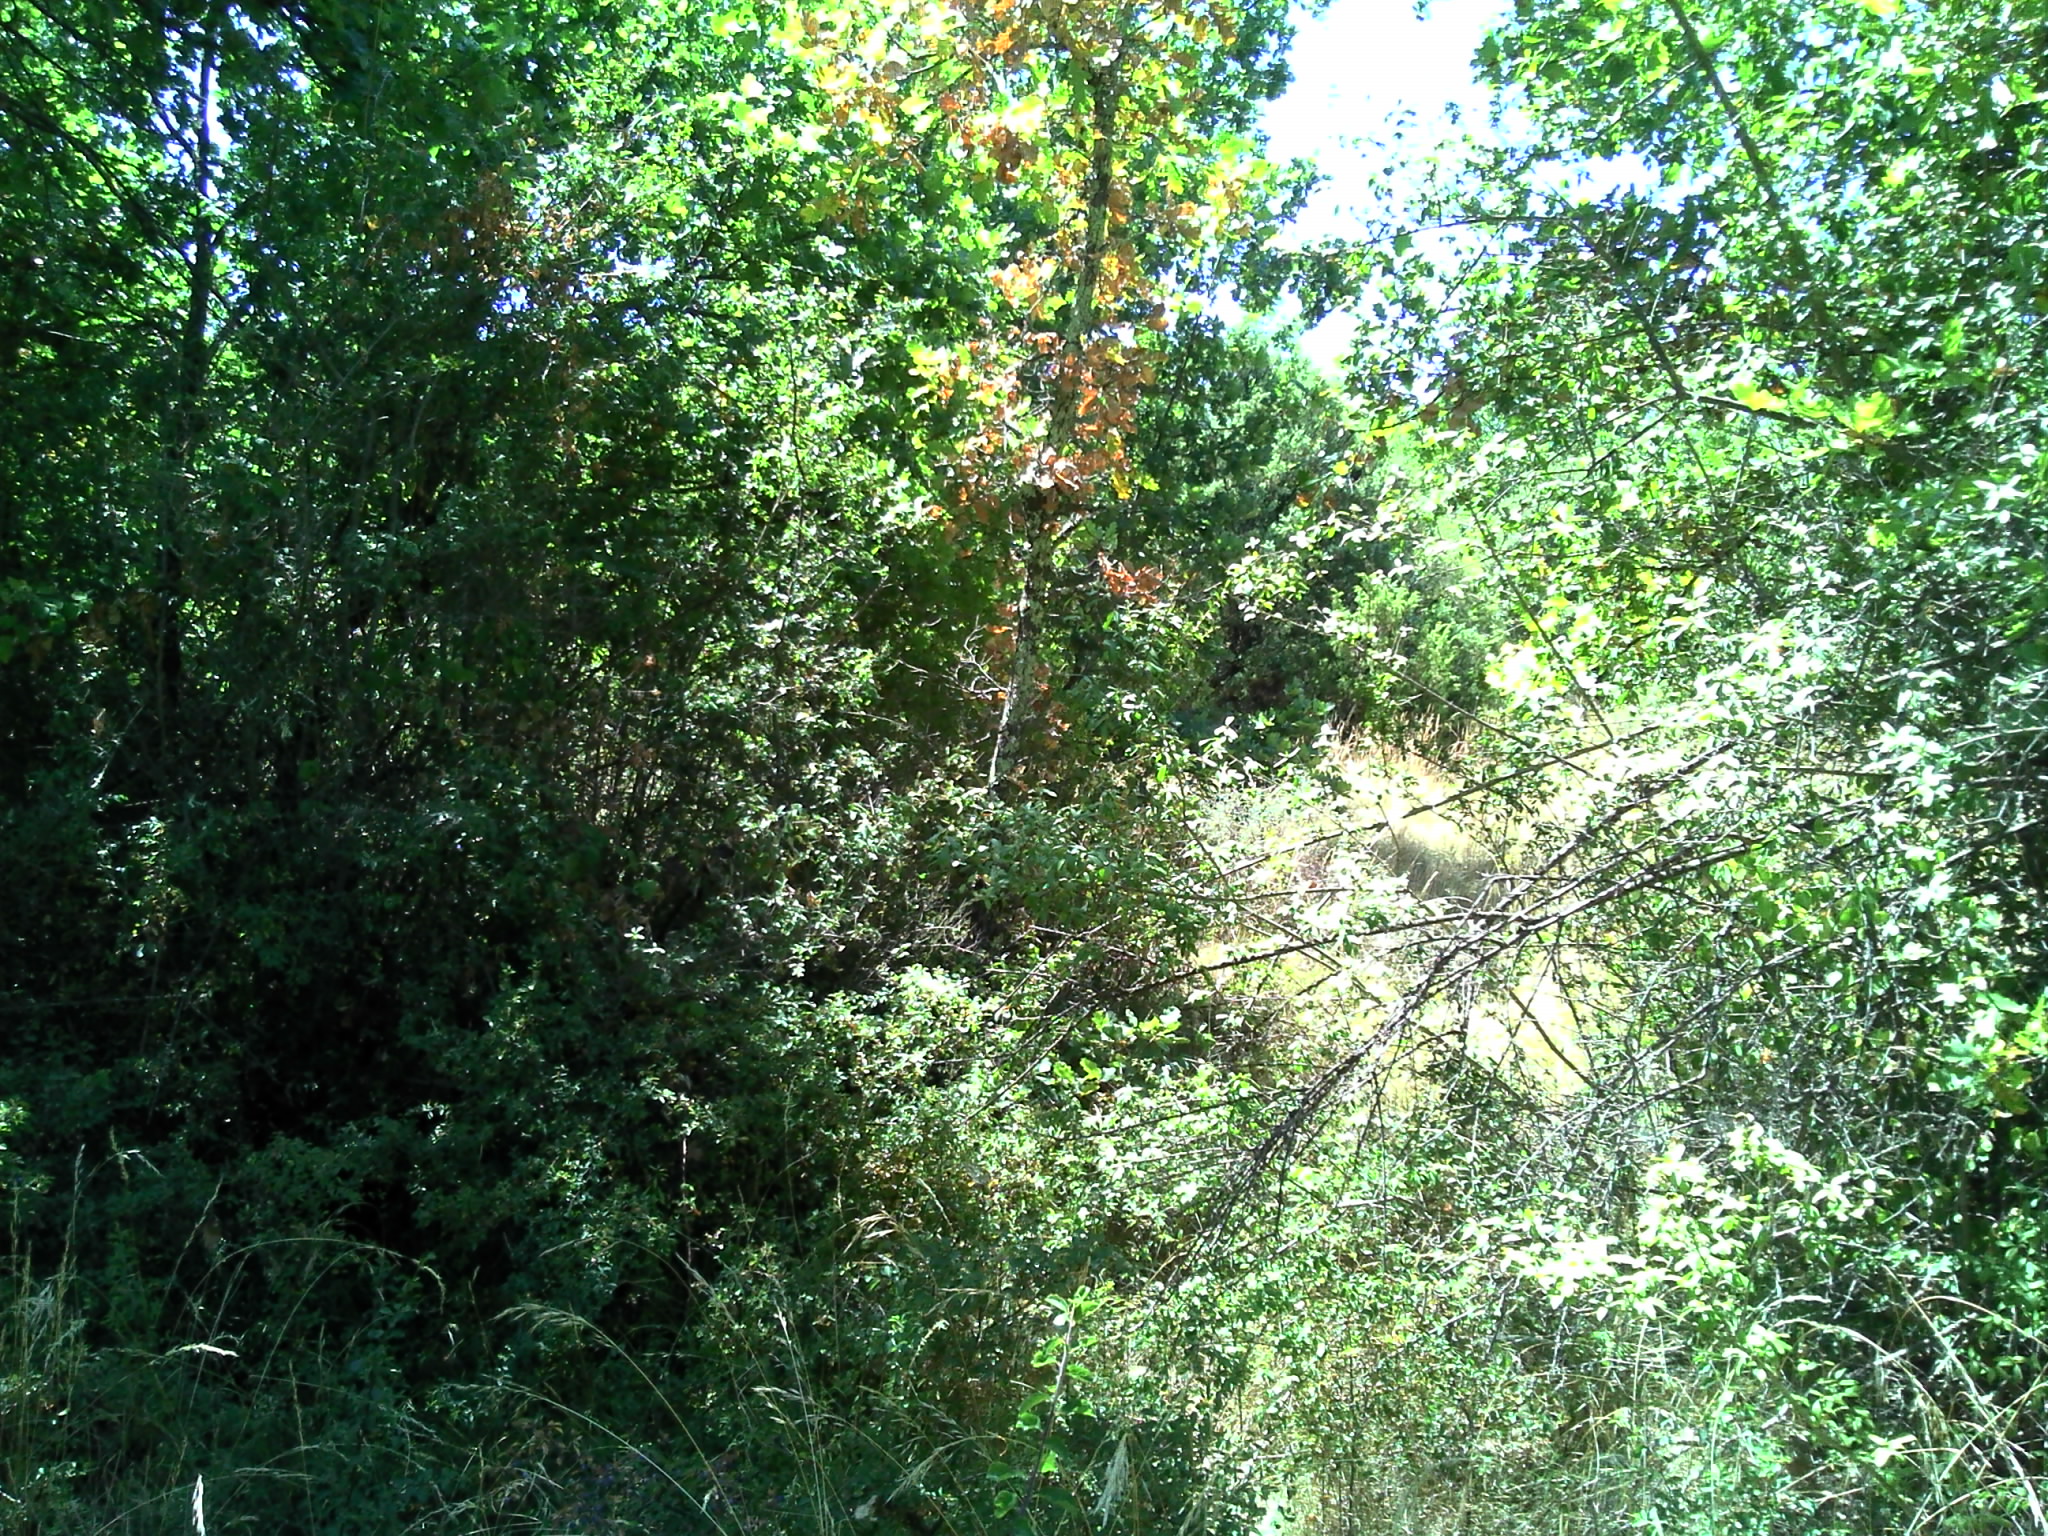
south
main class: Woodland
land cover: Other mixed woodland
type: broadleaved evergreen forest
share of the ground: > 75 %
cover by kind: broadleaved forest trees 50 %, coniferous forest trees 25 %, shrubs 20 %, herbaceous plants 5 %
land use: Semi-natural and natural areas not in use
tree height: > 5 m
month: July
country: FR
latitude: 44.1781
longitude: 4.3413
